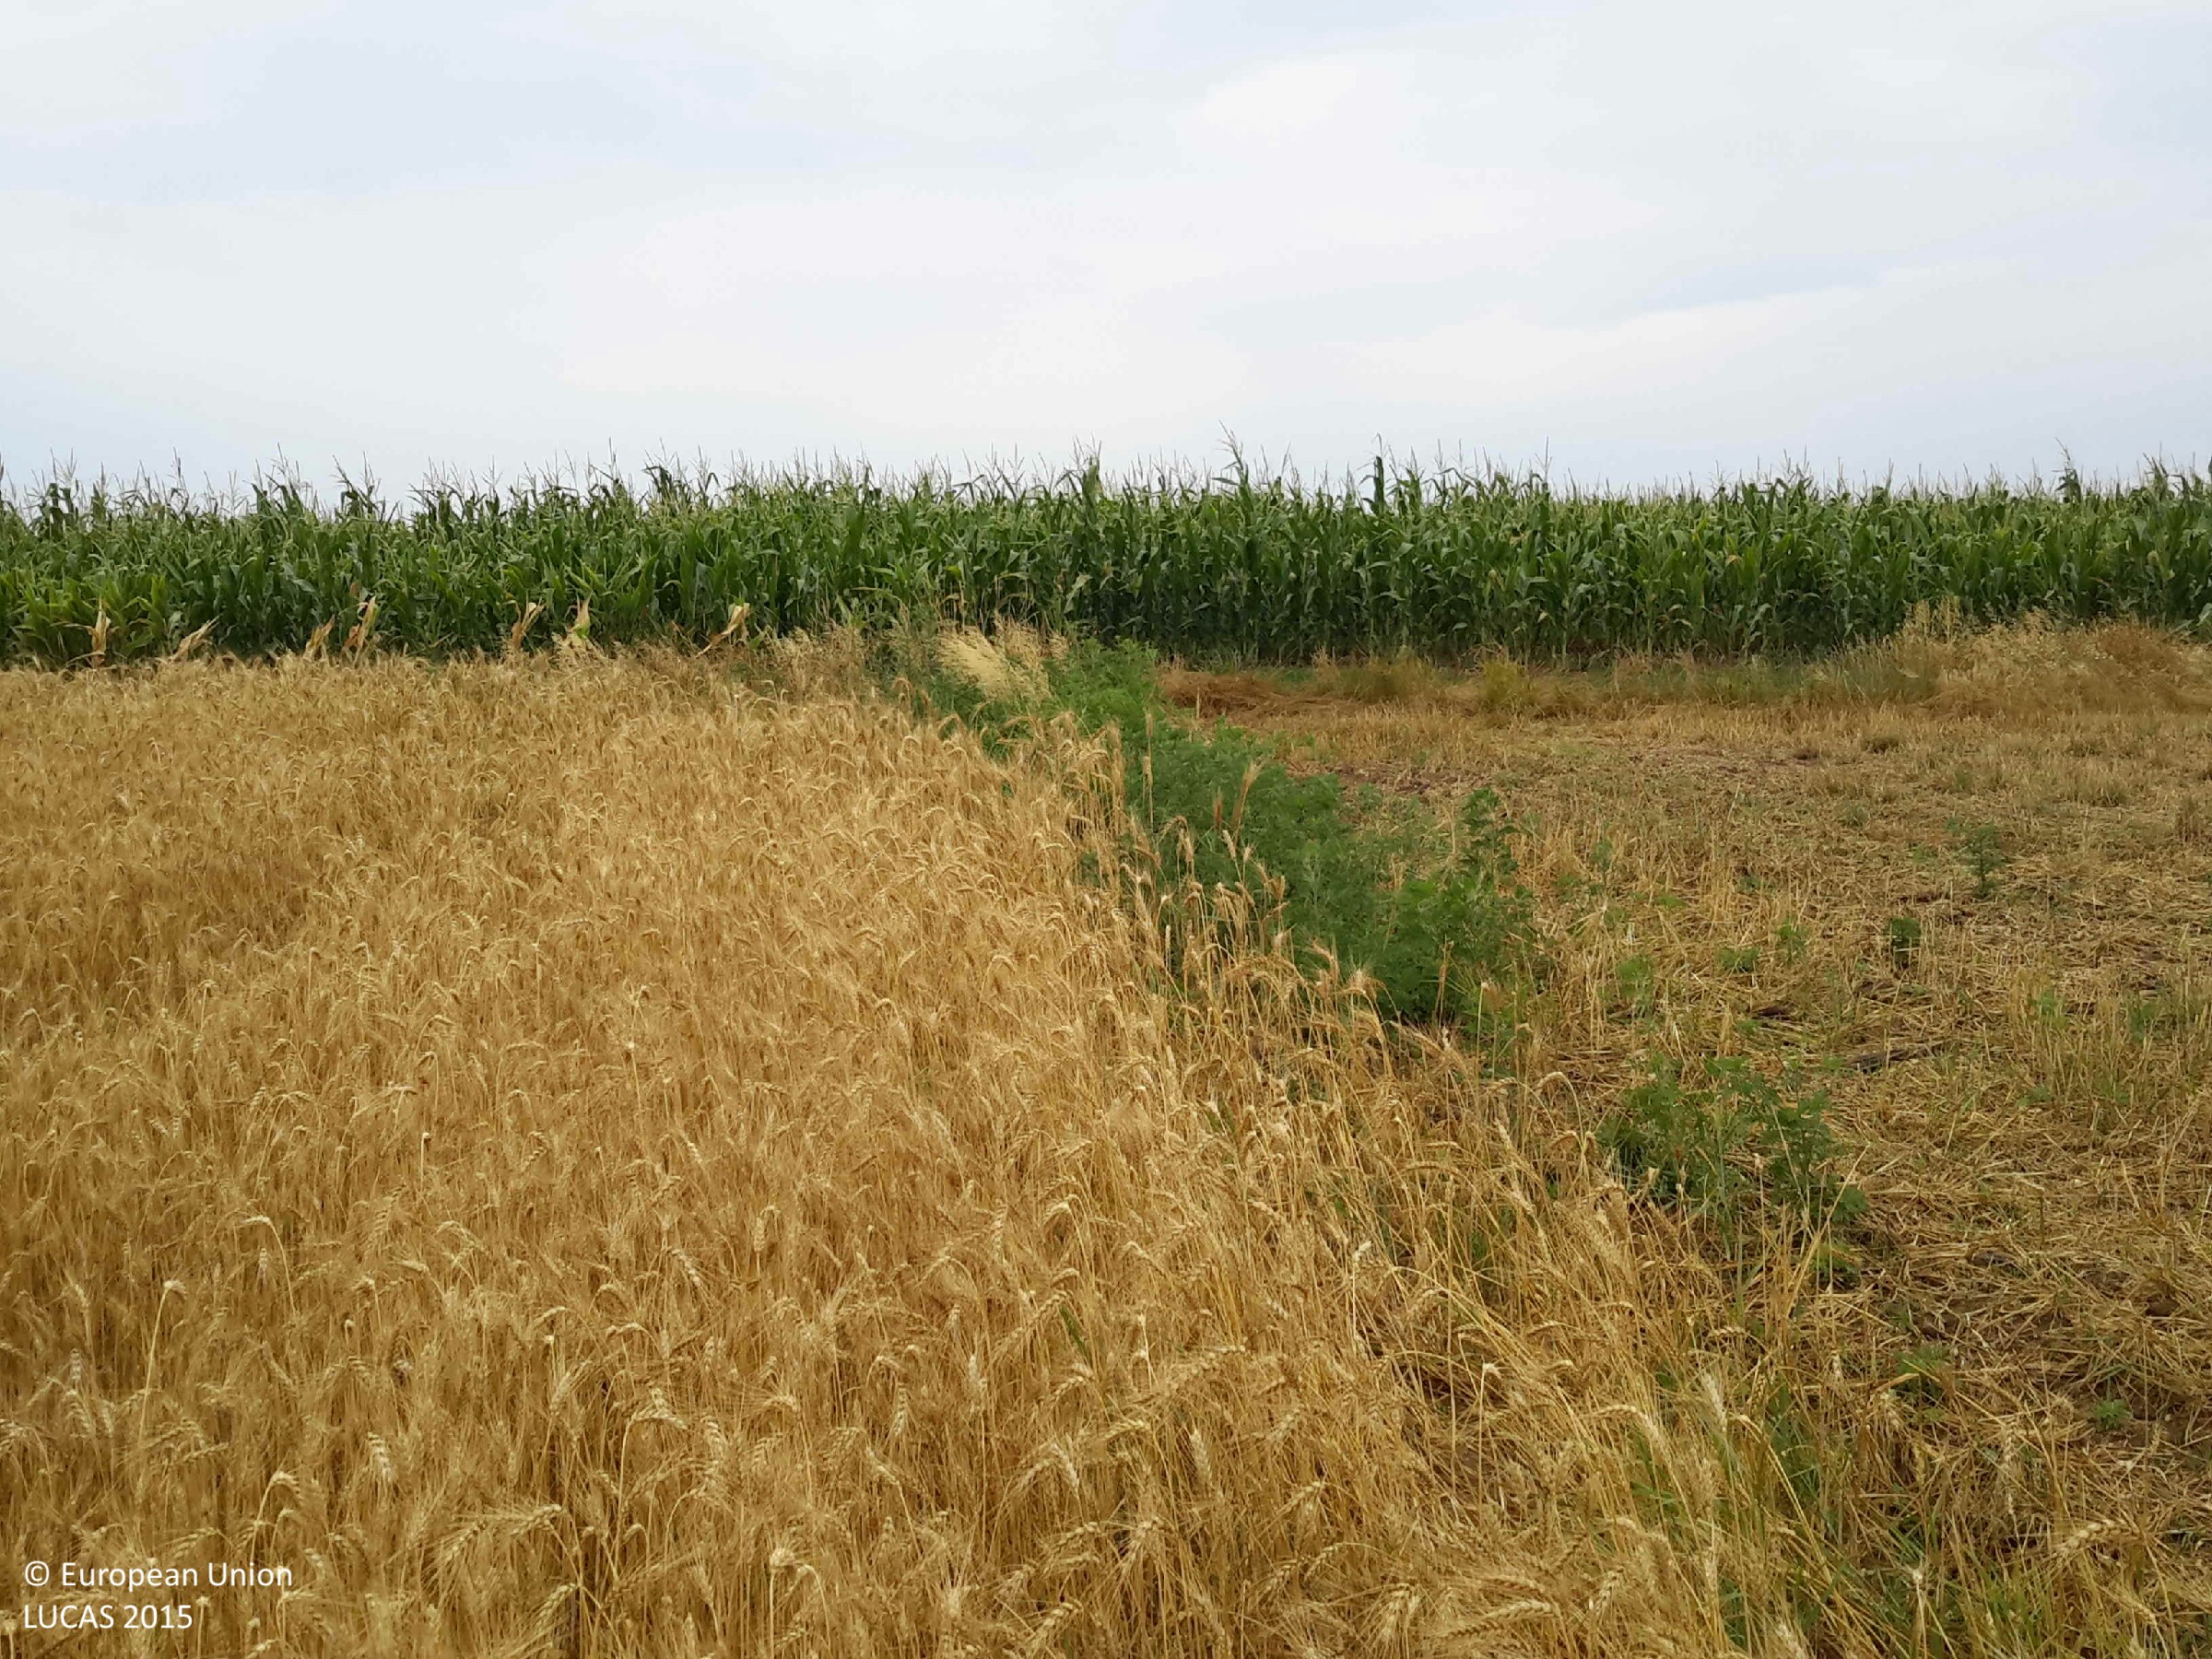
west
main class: Cropland
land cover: Common wheat
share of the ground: > 75 %
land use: Agriculture (excluding fallow land and kitchen gardens)
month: July
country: HU
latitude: 47.1214
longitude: 17.1891
